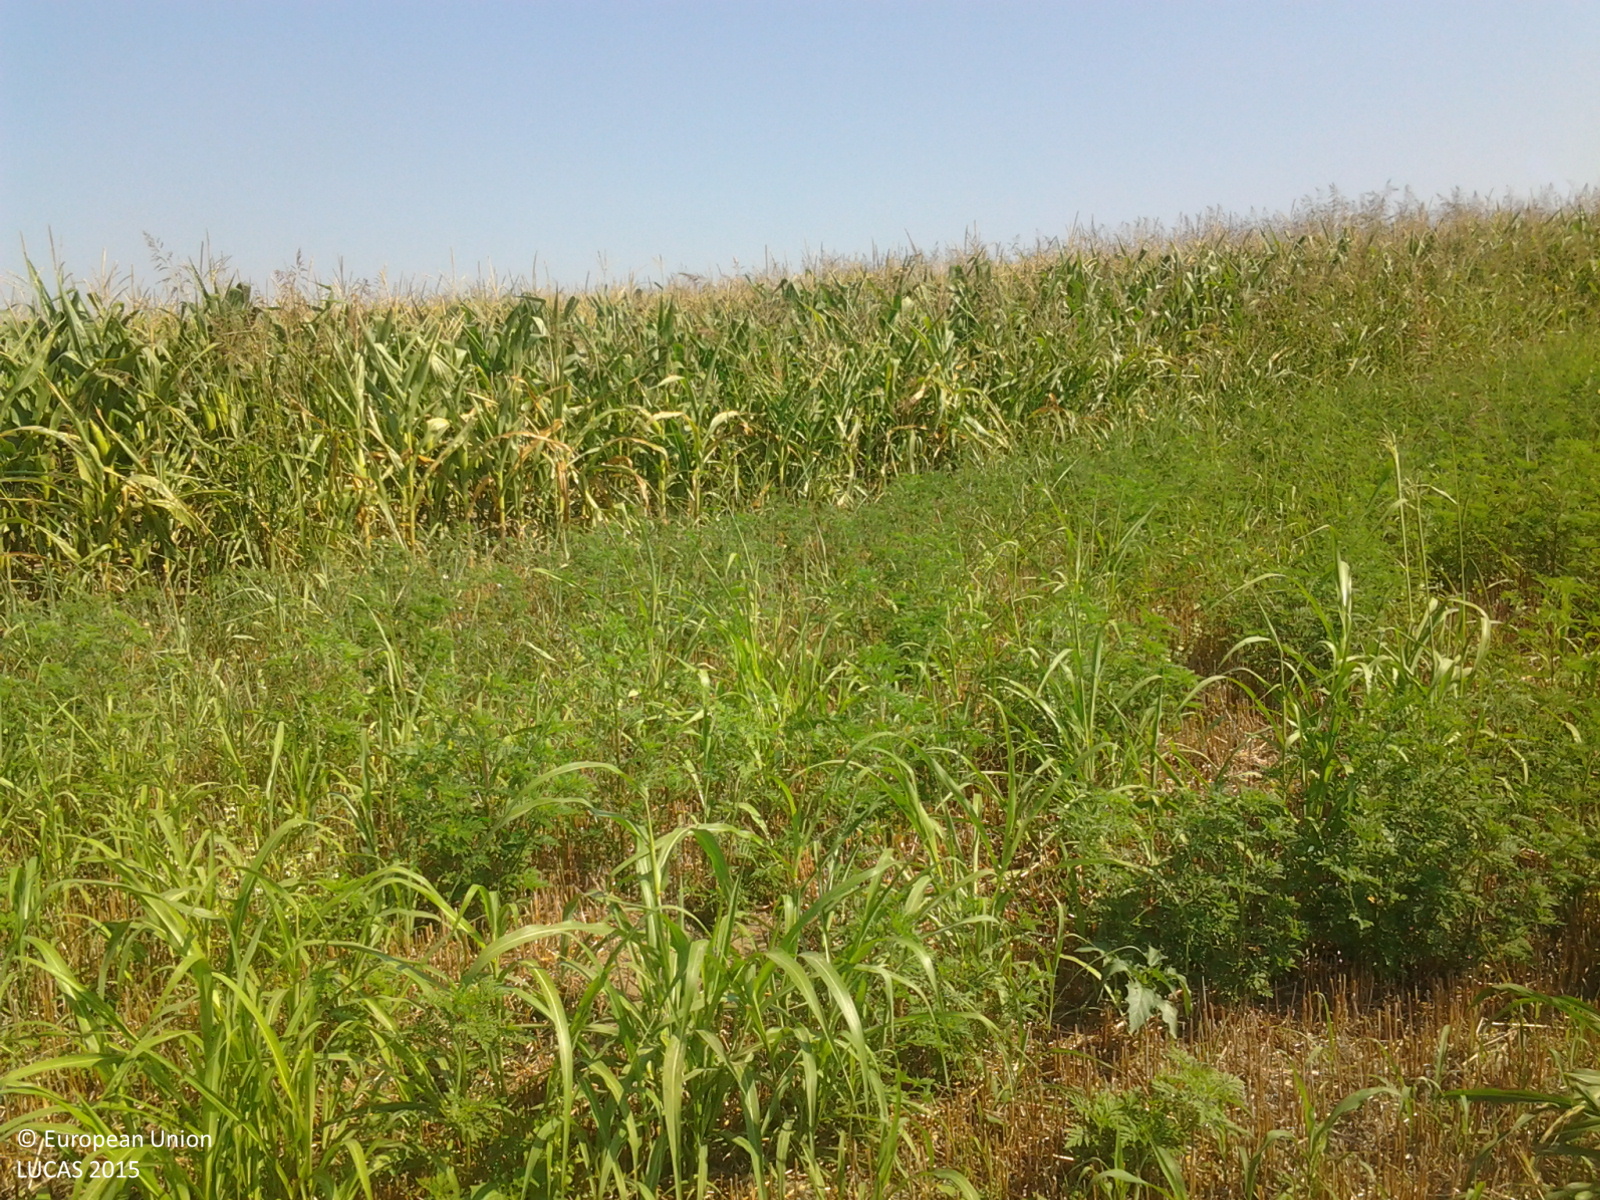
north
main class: Cropland
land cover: Common wheat
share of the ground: < 10 %
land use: Agriculture (excluding fallow land and kitchen gardens)
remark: Harvested field
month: August
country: HU
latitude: 46.7980
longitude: 18.4092
